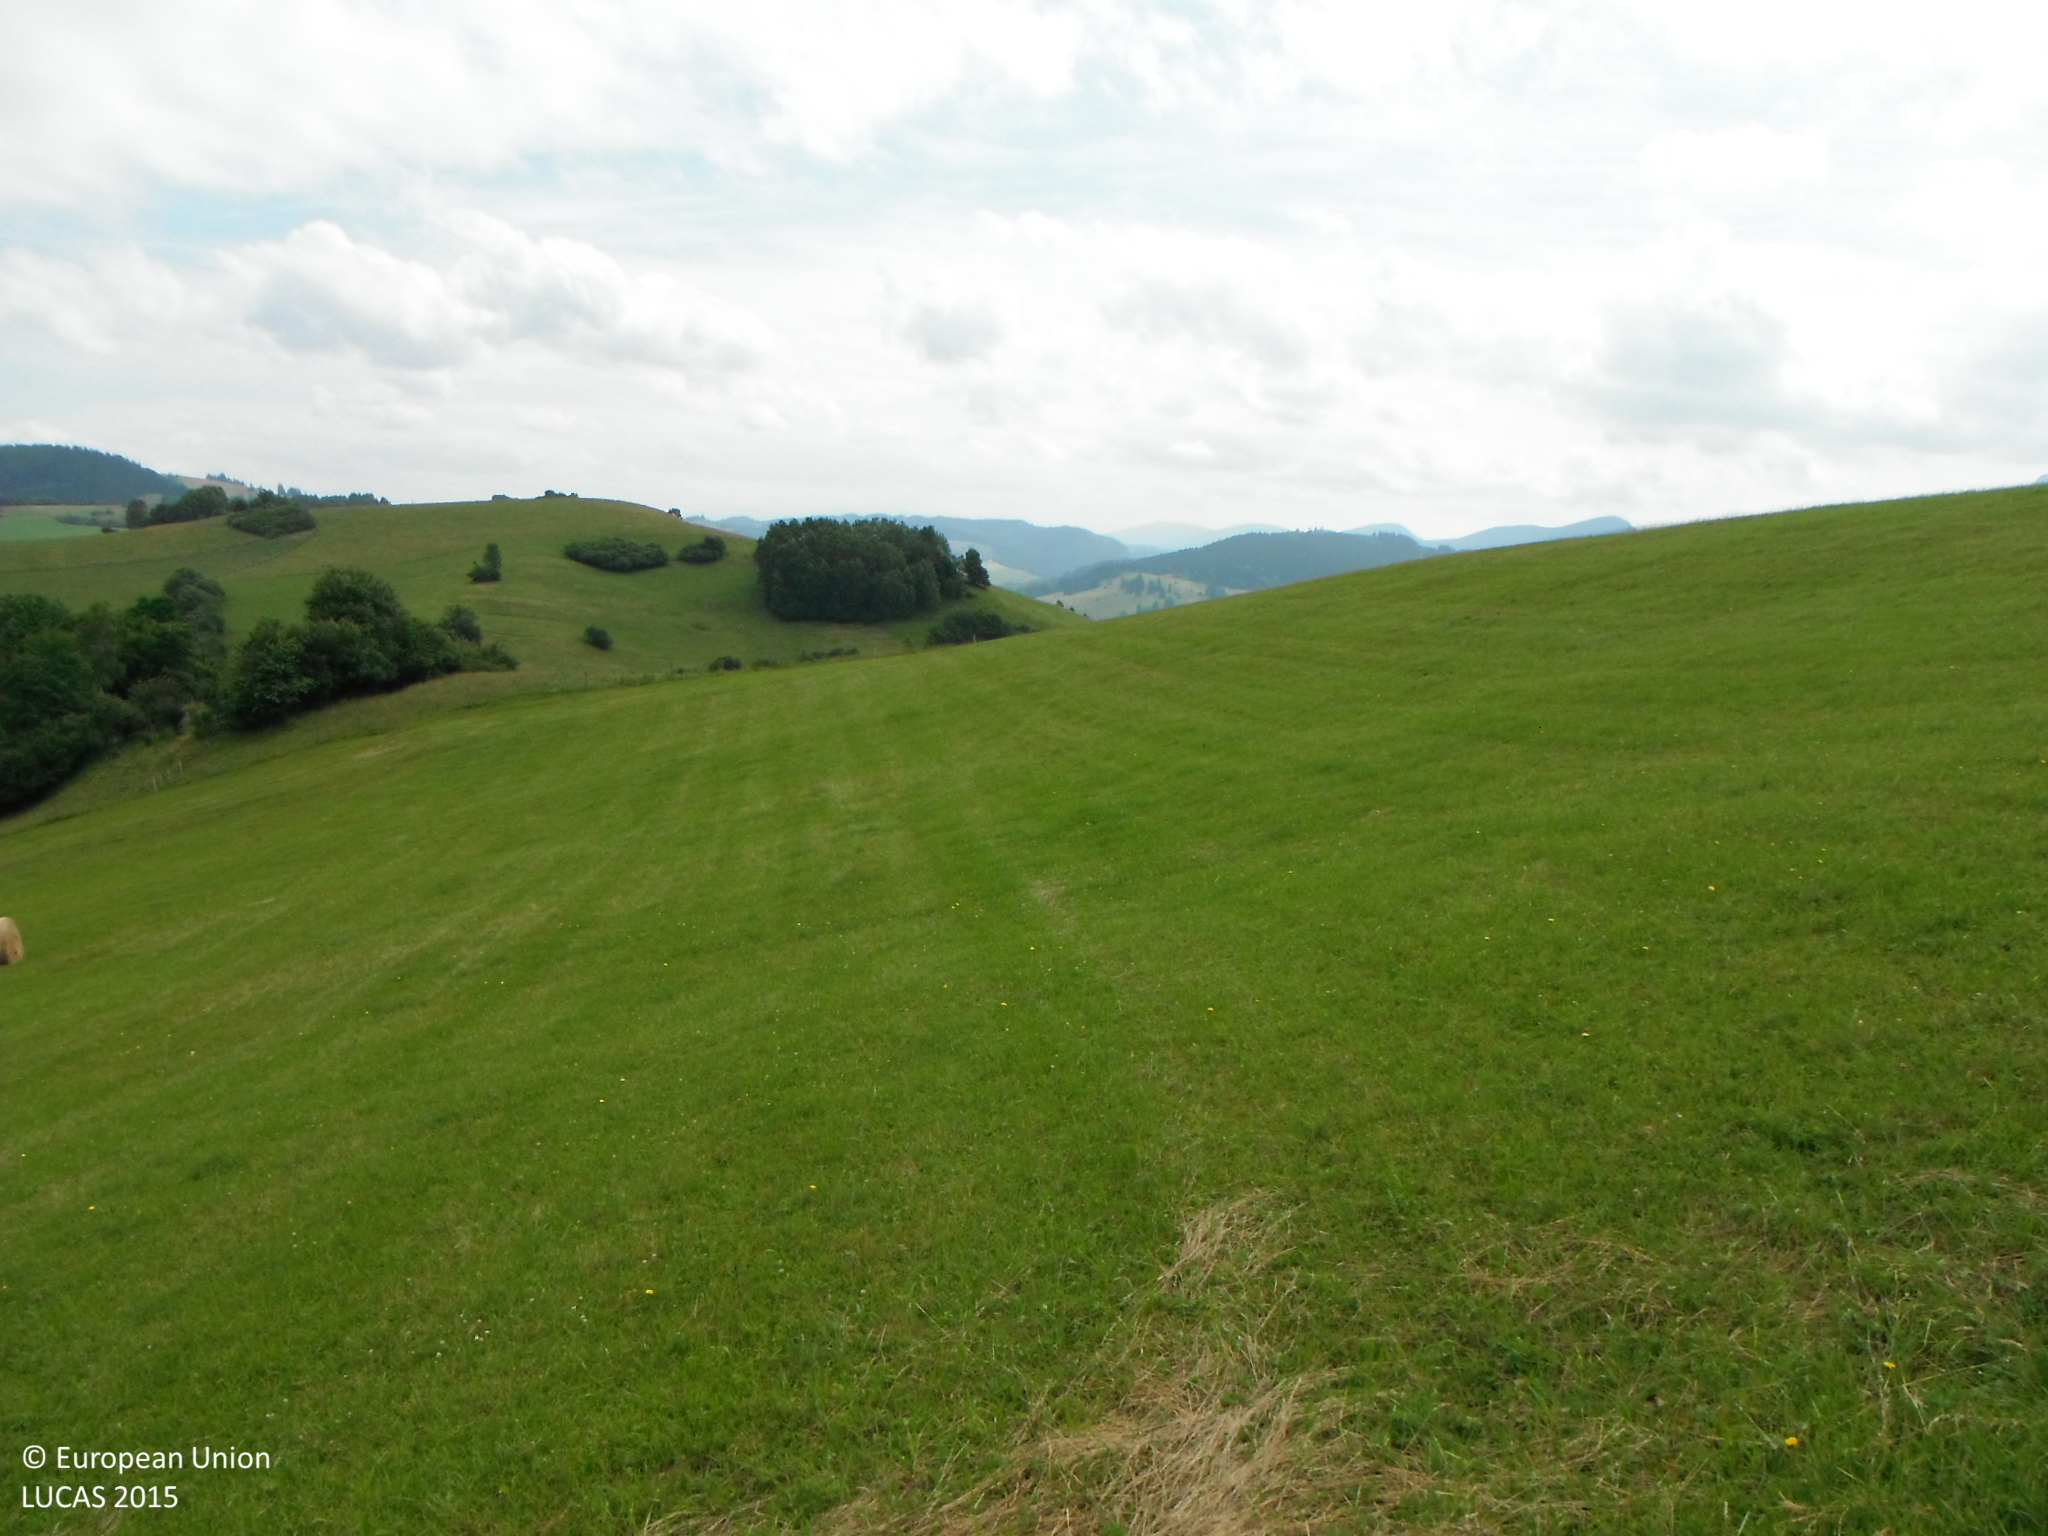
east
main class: Grassland
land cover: Grassland without tree/shrub cover
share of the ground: > 75 %
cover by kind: herbaceous plants 100 %
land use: Agriculture (excluding fallow land and kitchen gardens)
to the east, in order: Grassland without tree/shrub cover; Fences; Grassland without tree/shrub cover; Shrubland without tree cover; Grassland without tree/shrub cover
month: June
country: SK
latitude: 49.2114
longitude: 19.2349
